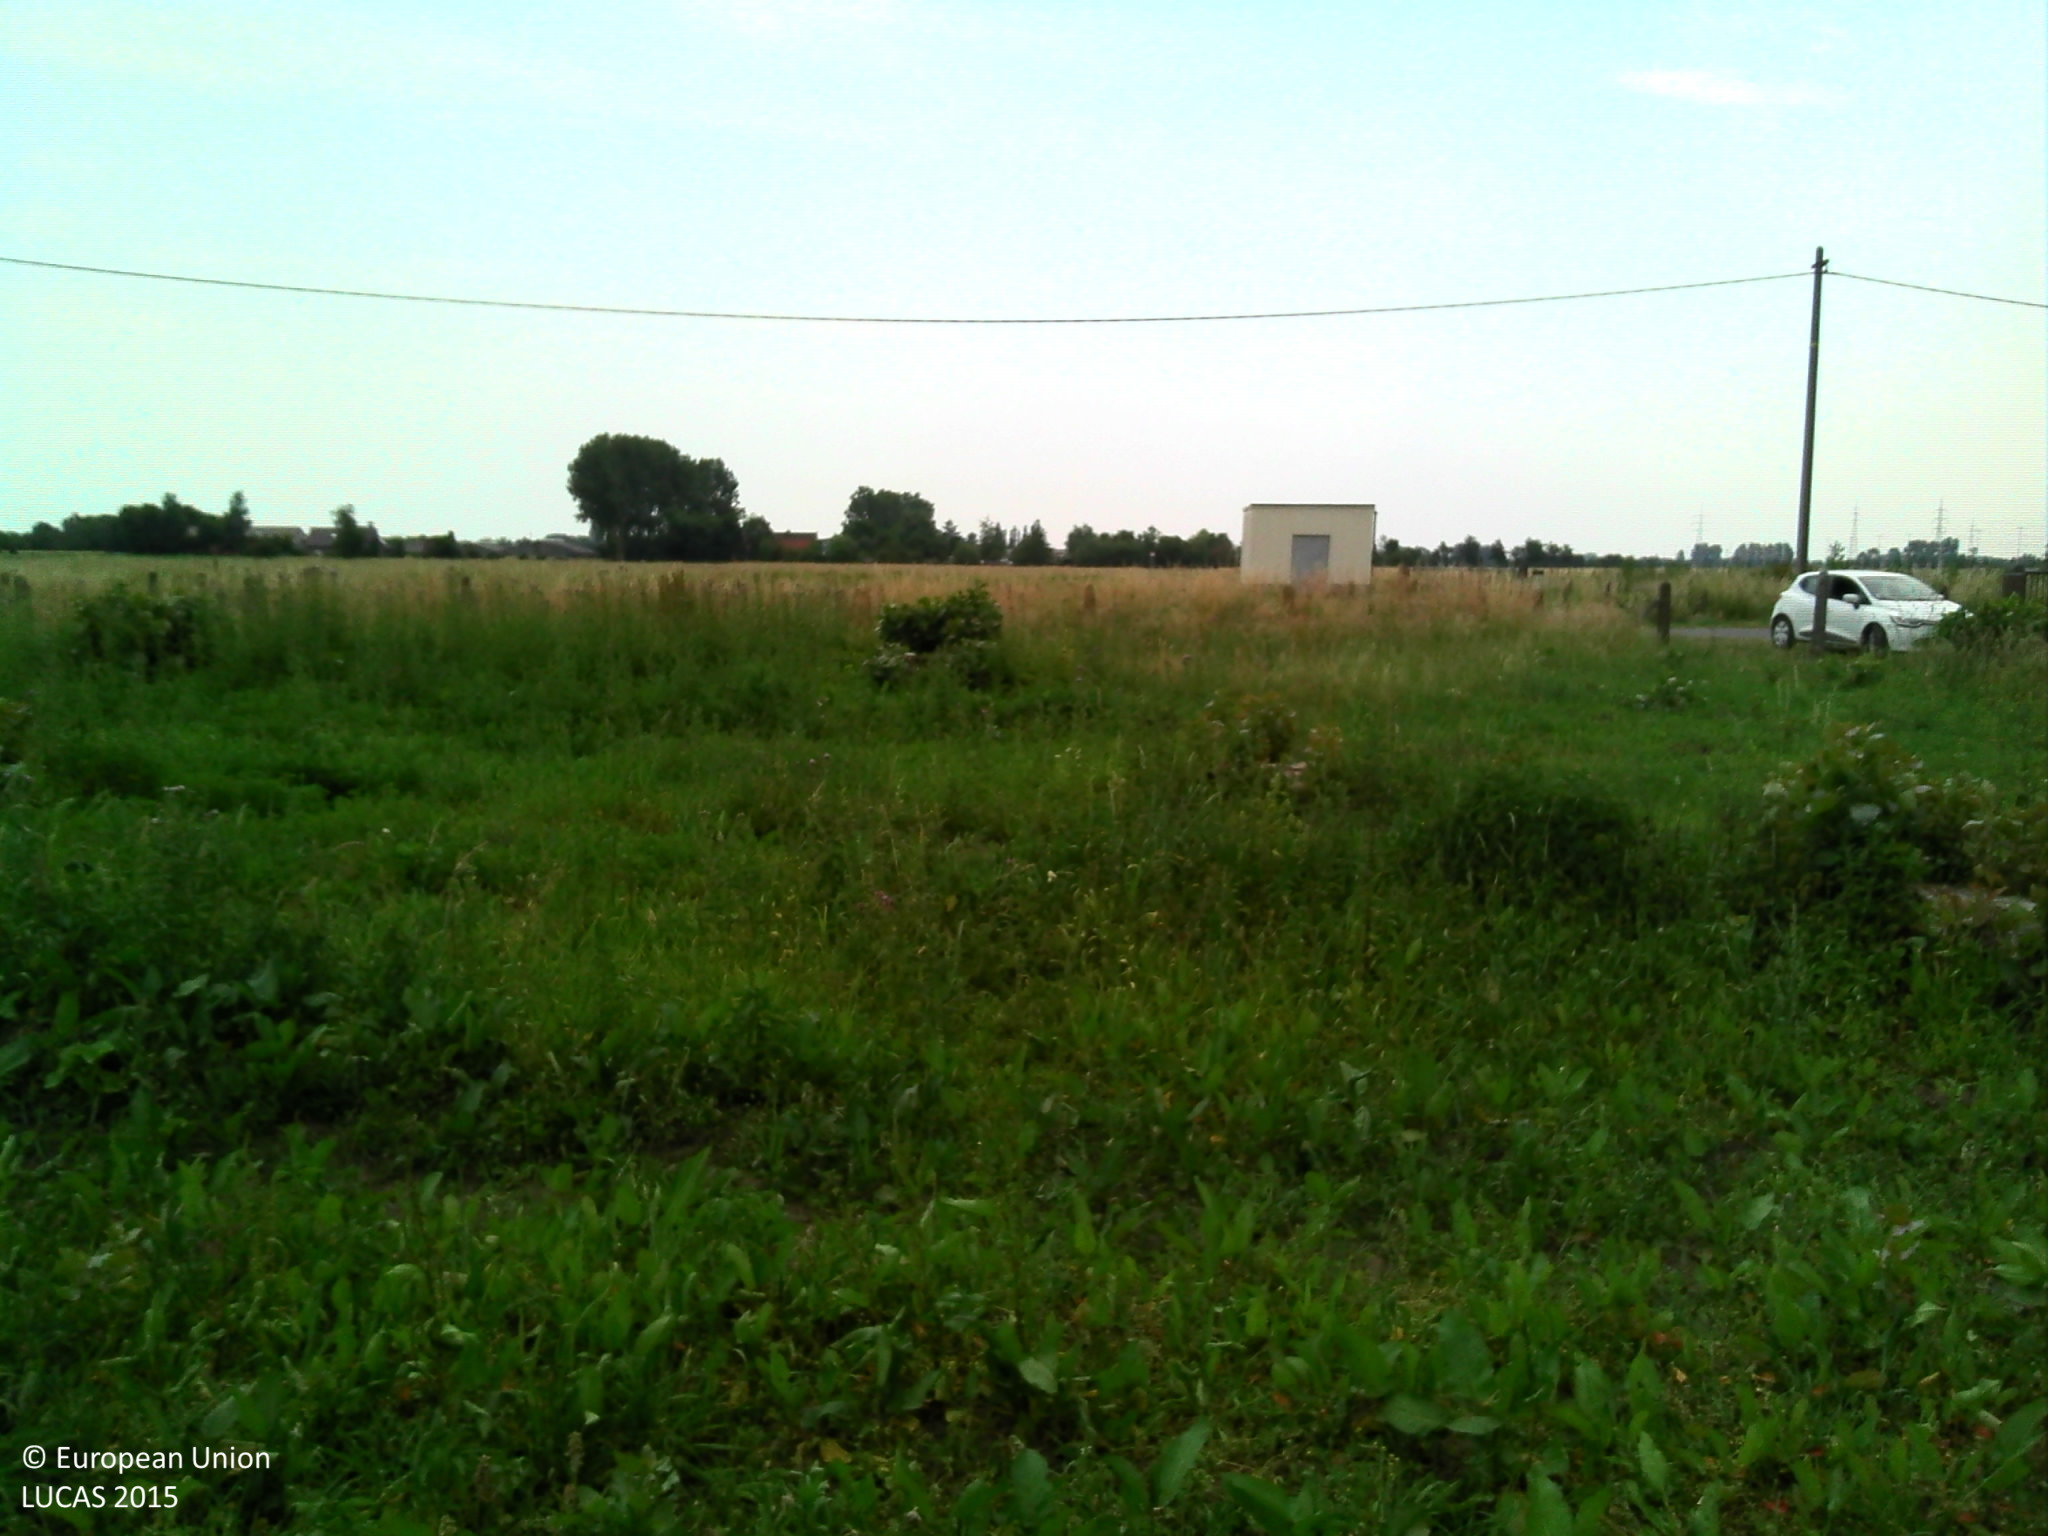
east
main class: Grassland
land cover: Spontaneously vegetated surfaces
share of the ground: > 75 %
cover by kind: herbaceous plants 100 %
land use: Forestry
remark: Clear cut
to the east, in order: Spontaneously vegetated surfaces; Fences; Grass margins; Ditches and canals; Grass margins; Paved roads, cycling and walking lanes; Grass margins; Electric lines; Ditches and canals; Grass margins; Fences; Grassland without tree/shrub cover; Artificial constructions in urban areas; Grassland without tree/shrub cover
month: July
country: BE
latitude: 51.2126
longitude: 3.5936
